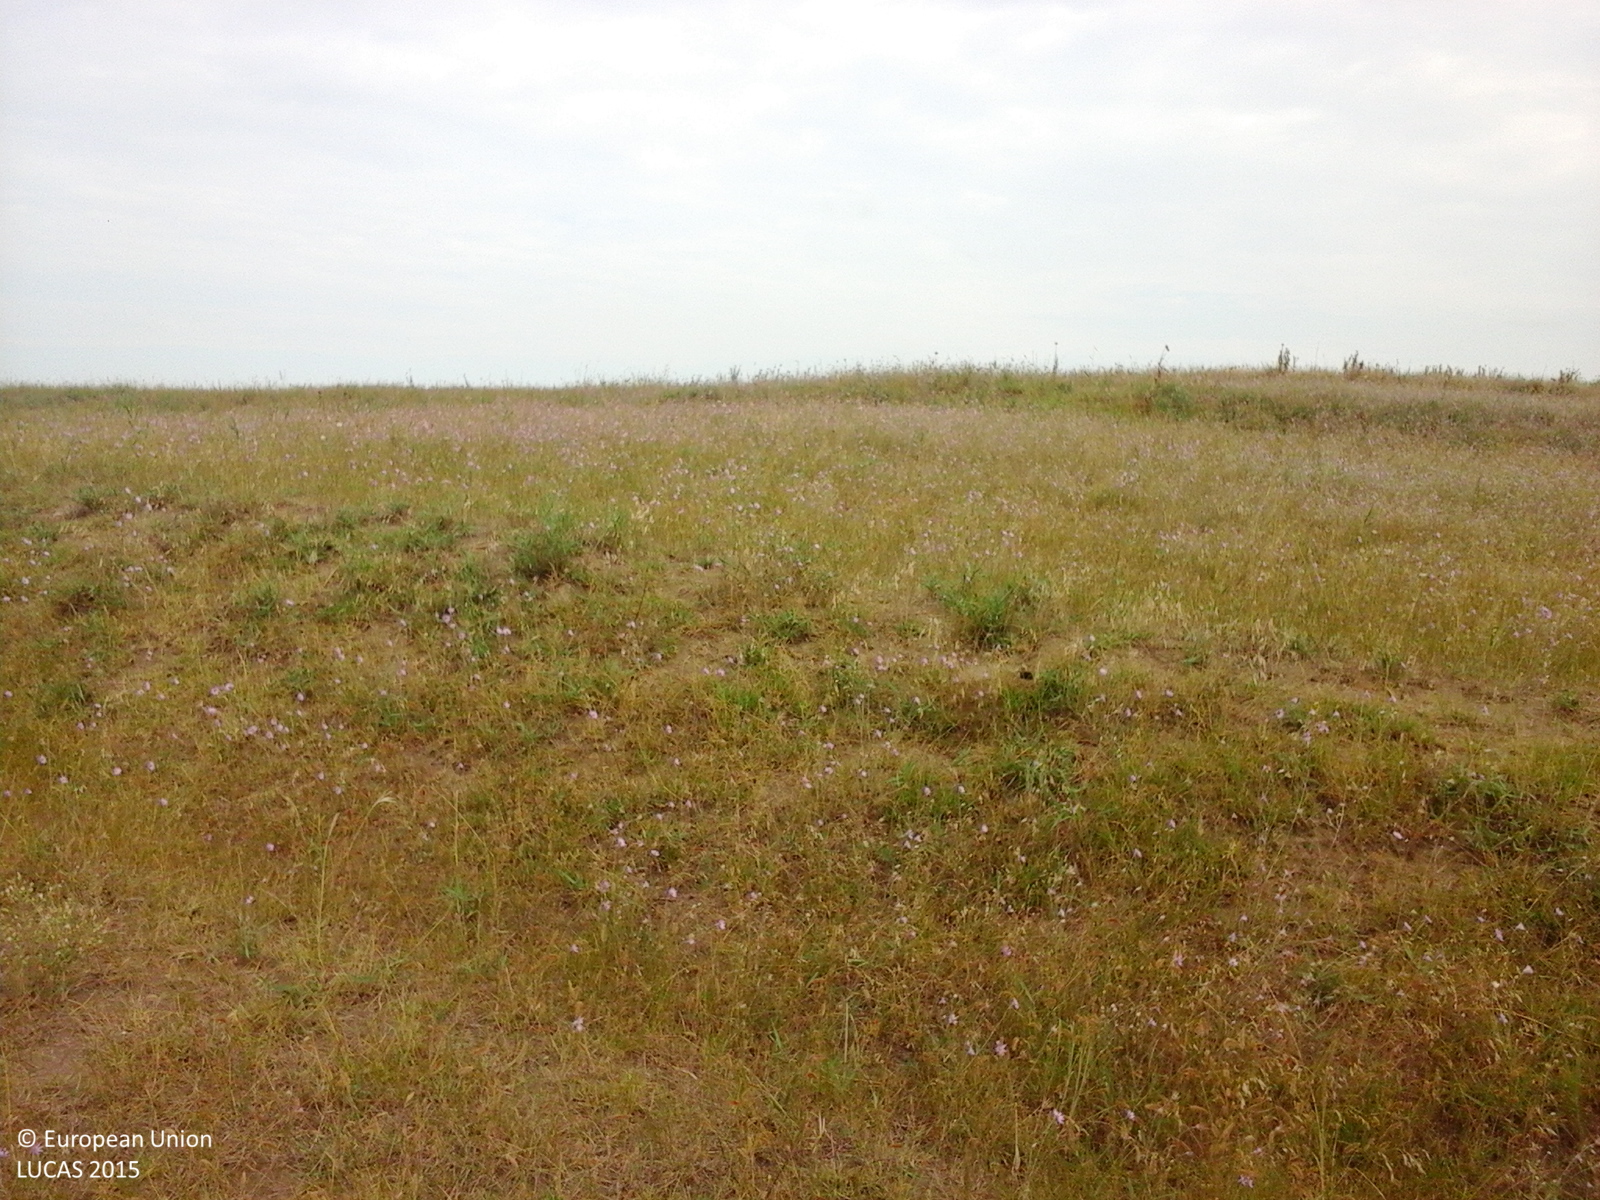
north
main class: Grassland
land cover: Grassland without tree/shrub cover
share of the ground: > 75 %
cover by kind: herbaceous plants 100 %
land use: Agriculture (excluding fallow land and kitchen gardens)
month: August
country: RO
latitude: 44.9078
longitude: 28.1655
